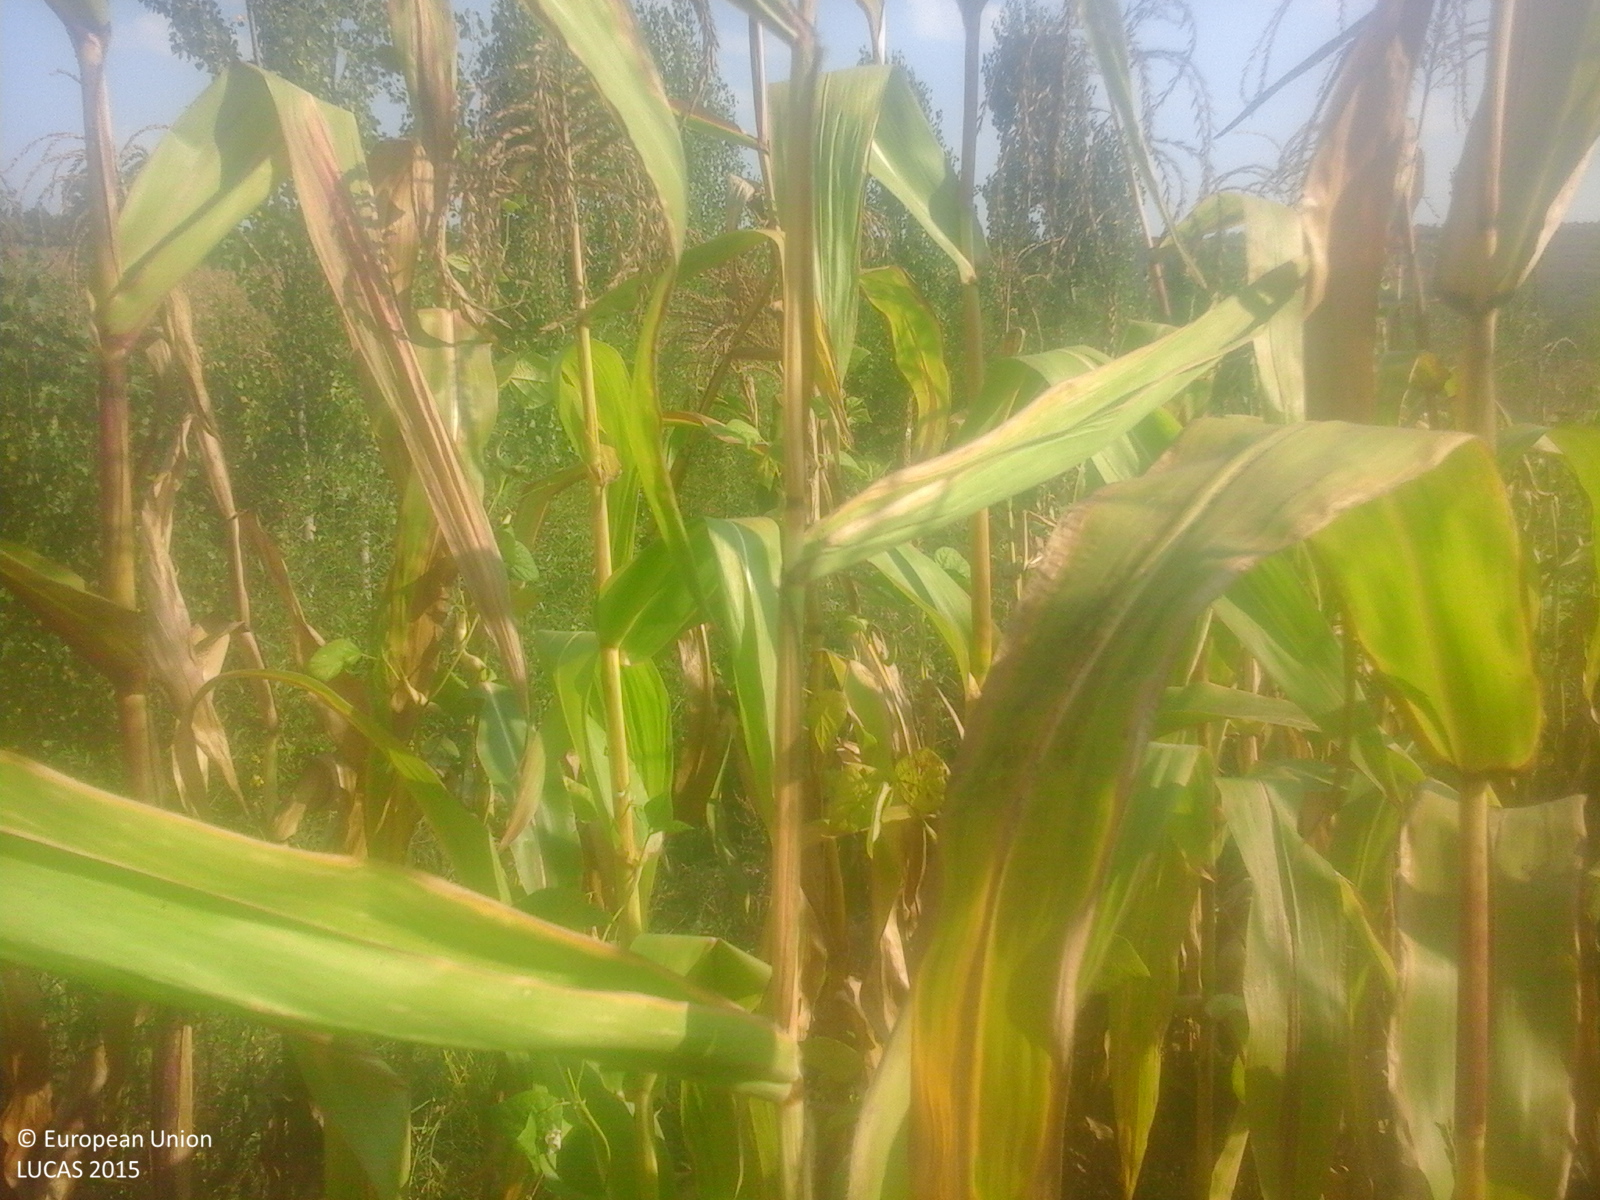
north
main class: Cropland
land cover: Maize
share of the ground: > 75 %
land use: Agriculture (excluding fallow land and kitchen gardens)
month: September
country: RO
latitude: 46.8592
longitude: 24.4779
